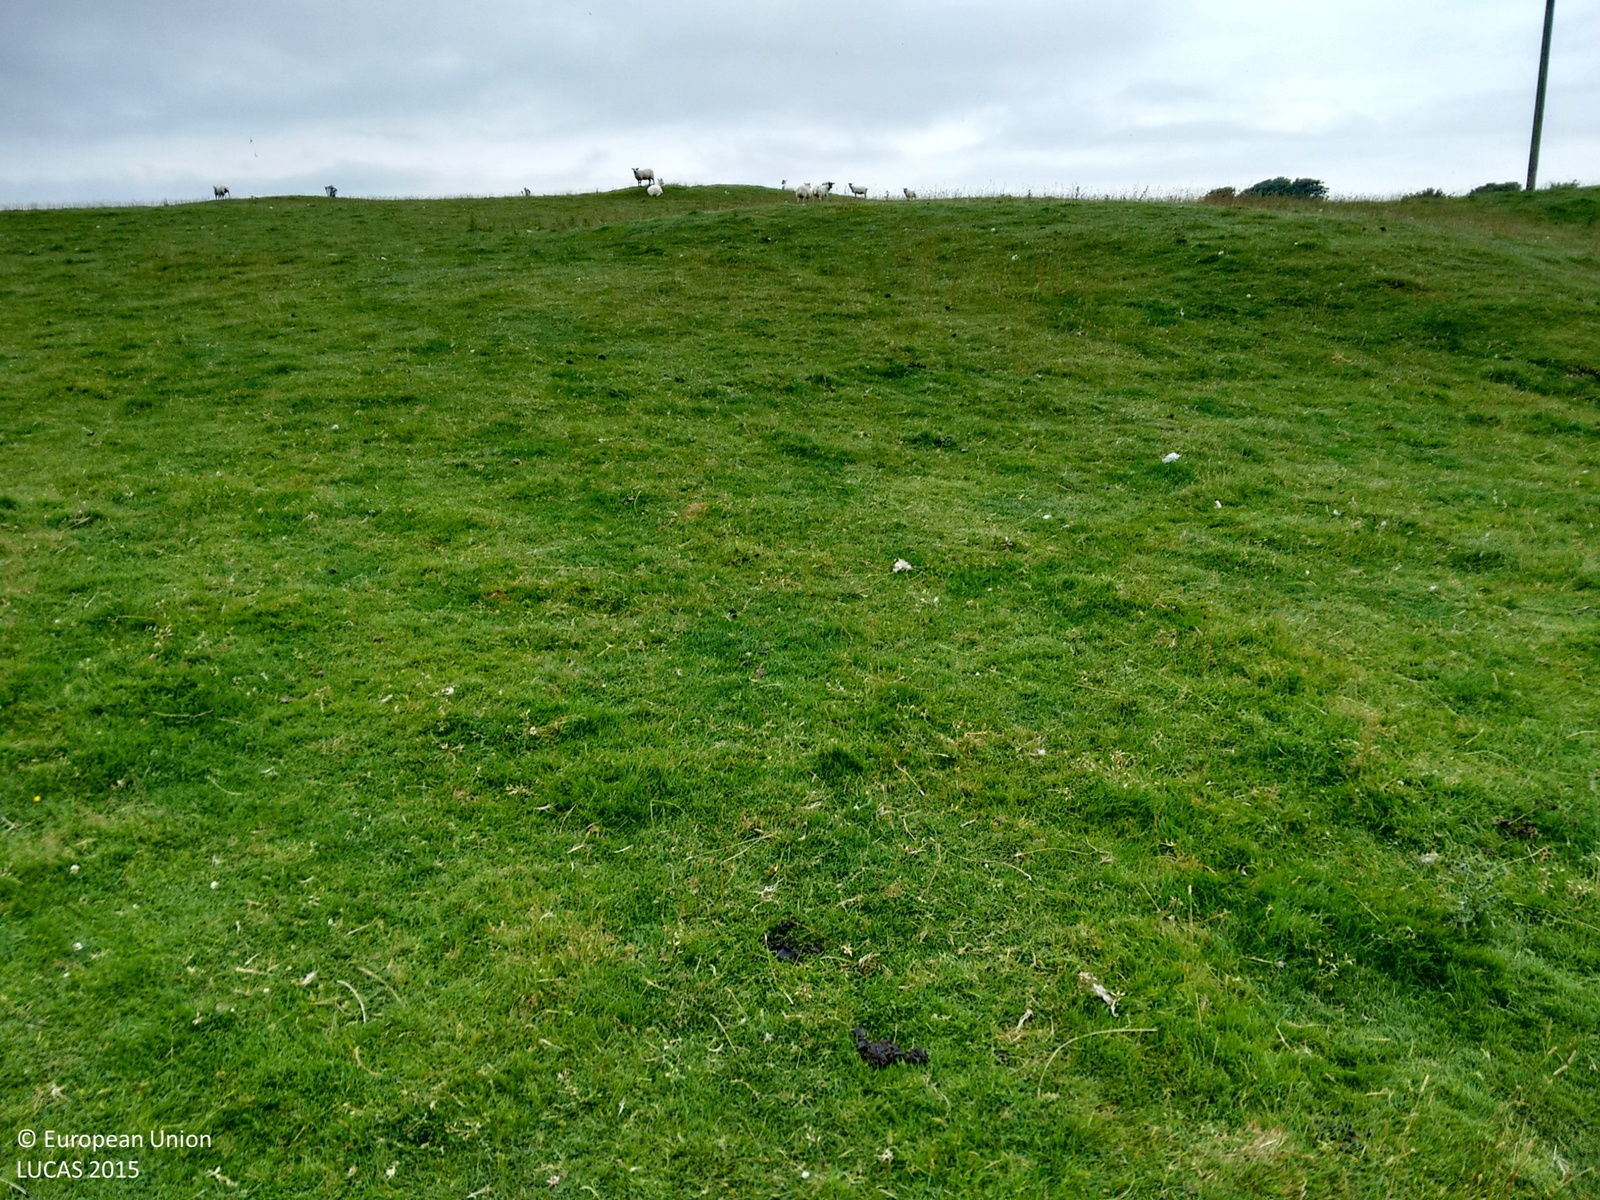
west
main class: Grassland
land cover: Grassland without tree/shrub cover
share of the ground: > 75 %
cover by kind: herbaceous plants 100 %
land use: Agriculture (excluding fallow land and kitchen gardens)
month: August
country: GB
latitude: 54.8932
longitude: -4.7163
